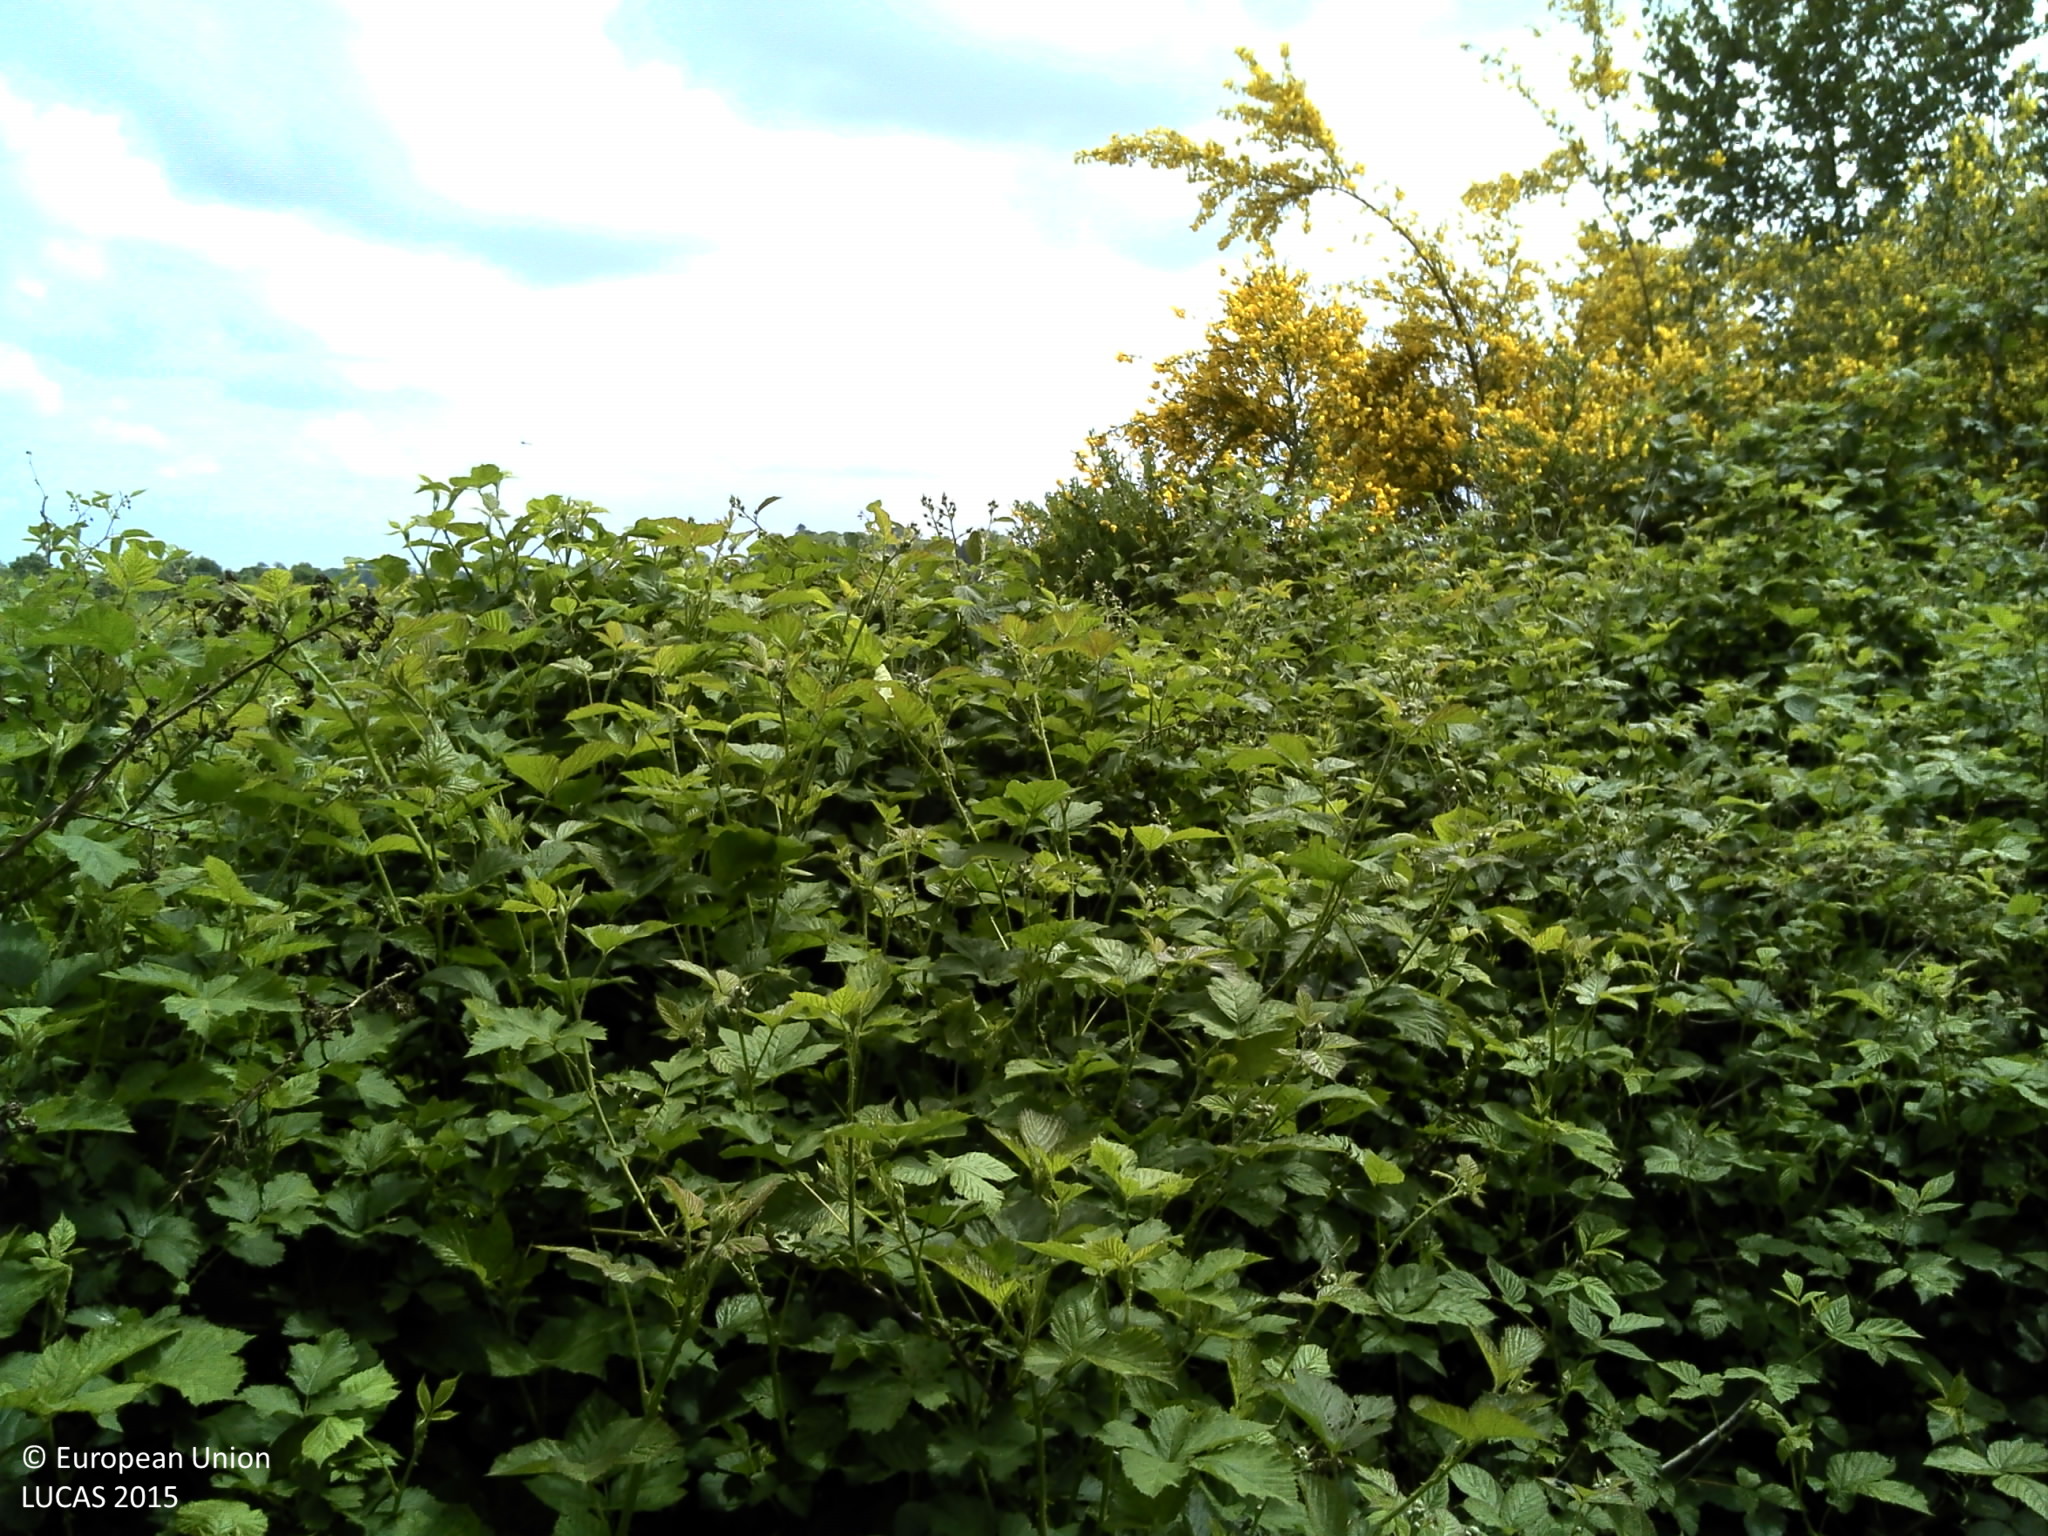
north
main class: Cropland
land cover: Rape and turnip rape
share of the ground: > 75 %
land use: Agriculture (excluding fallow land and kitchen gardens)
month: May
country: FR
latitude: 49.5541
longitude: 1.2015
